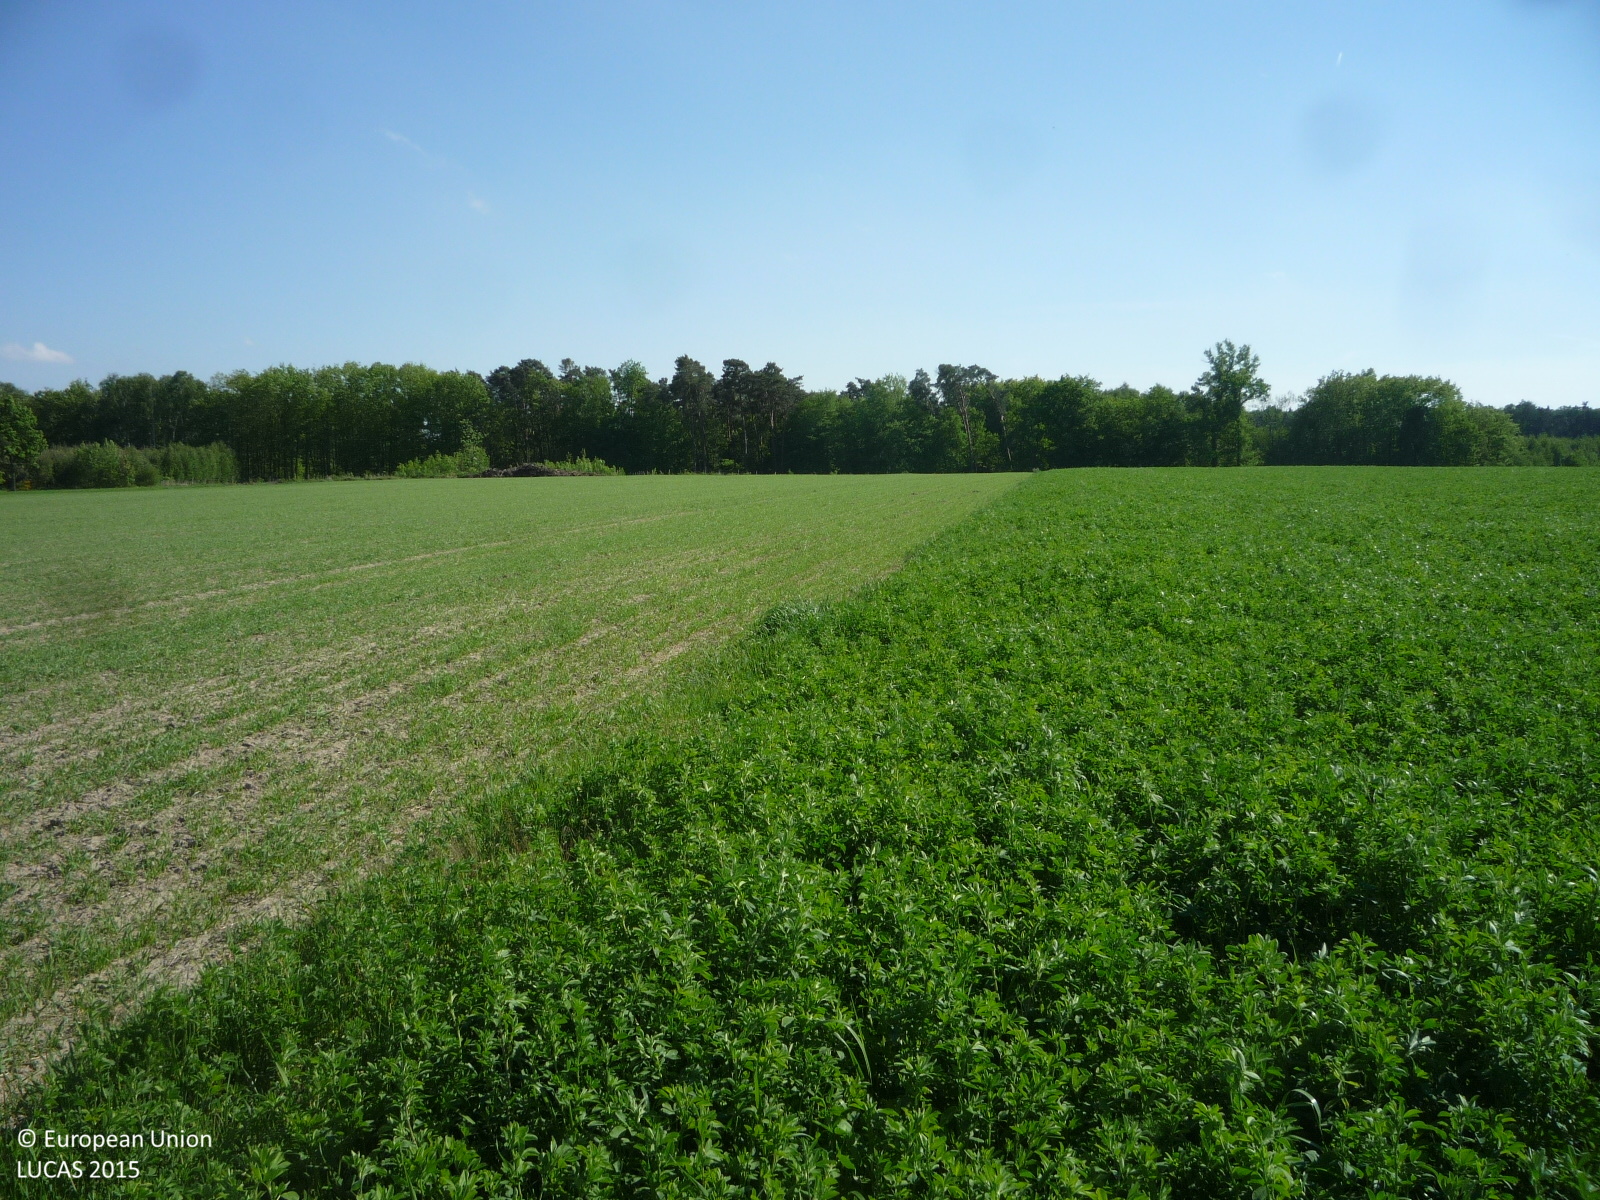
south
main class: Cropland
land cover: Lucerne
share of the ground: > 75 %
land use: Agriculture (excluding fallow land and kitchen gardens)
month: May
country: CZ
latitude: 50.3235
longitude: 14.6512
